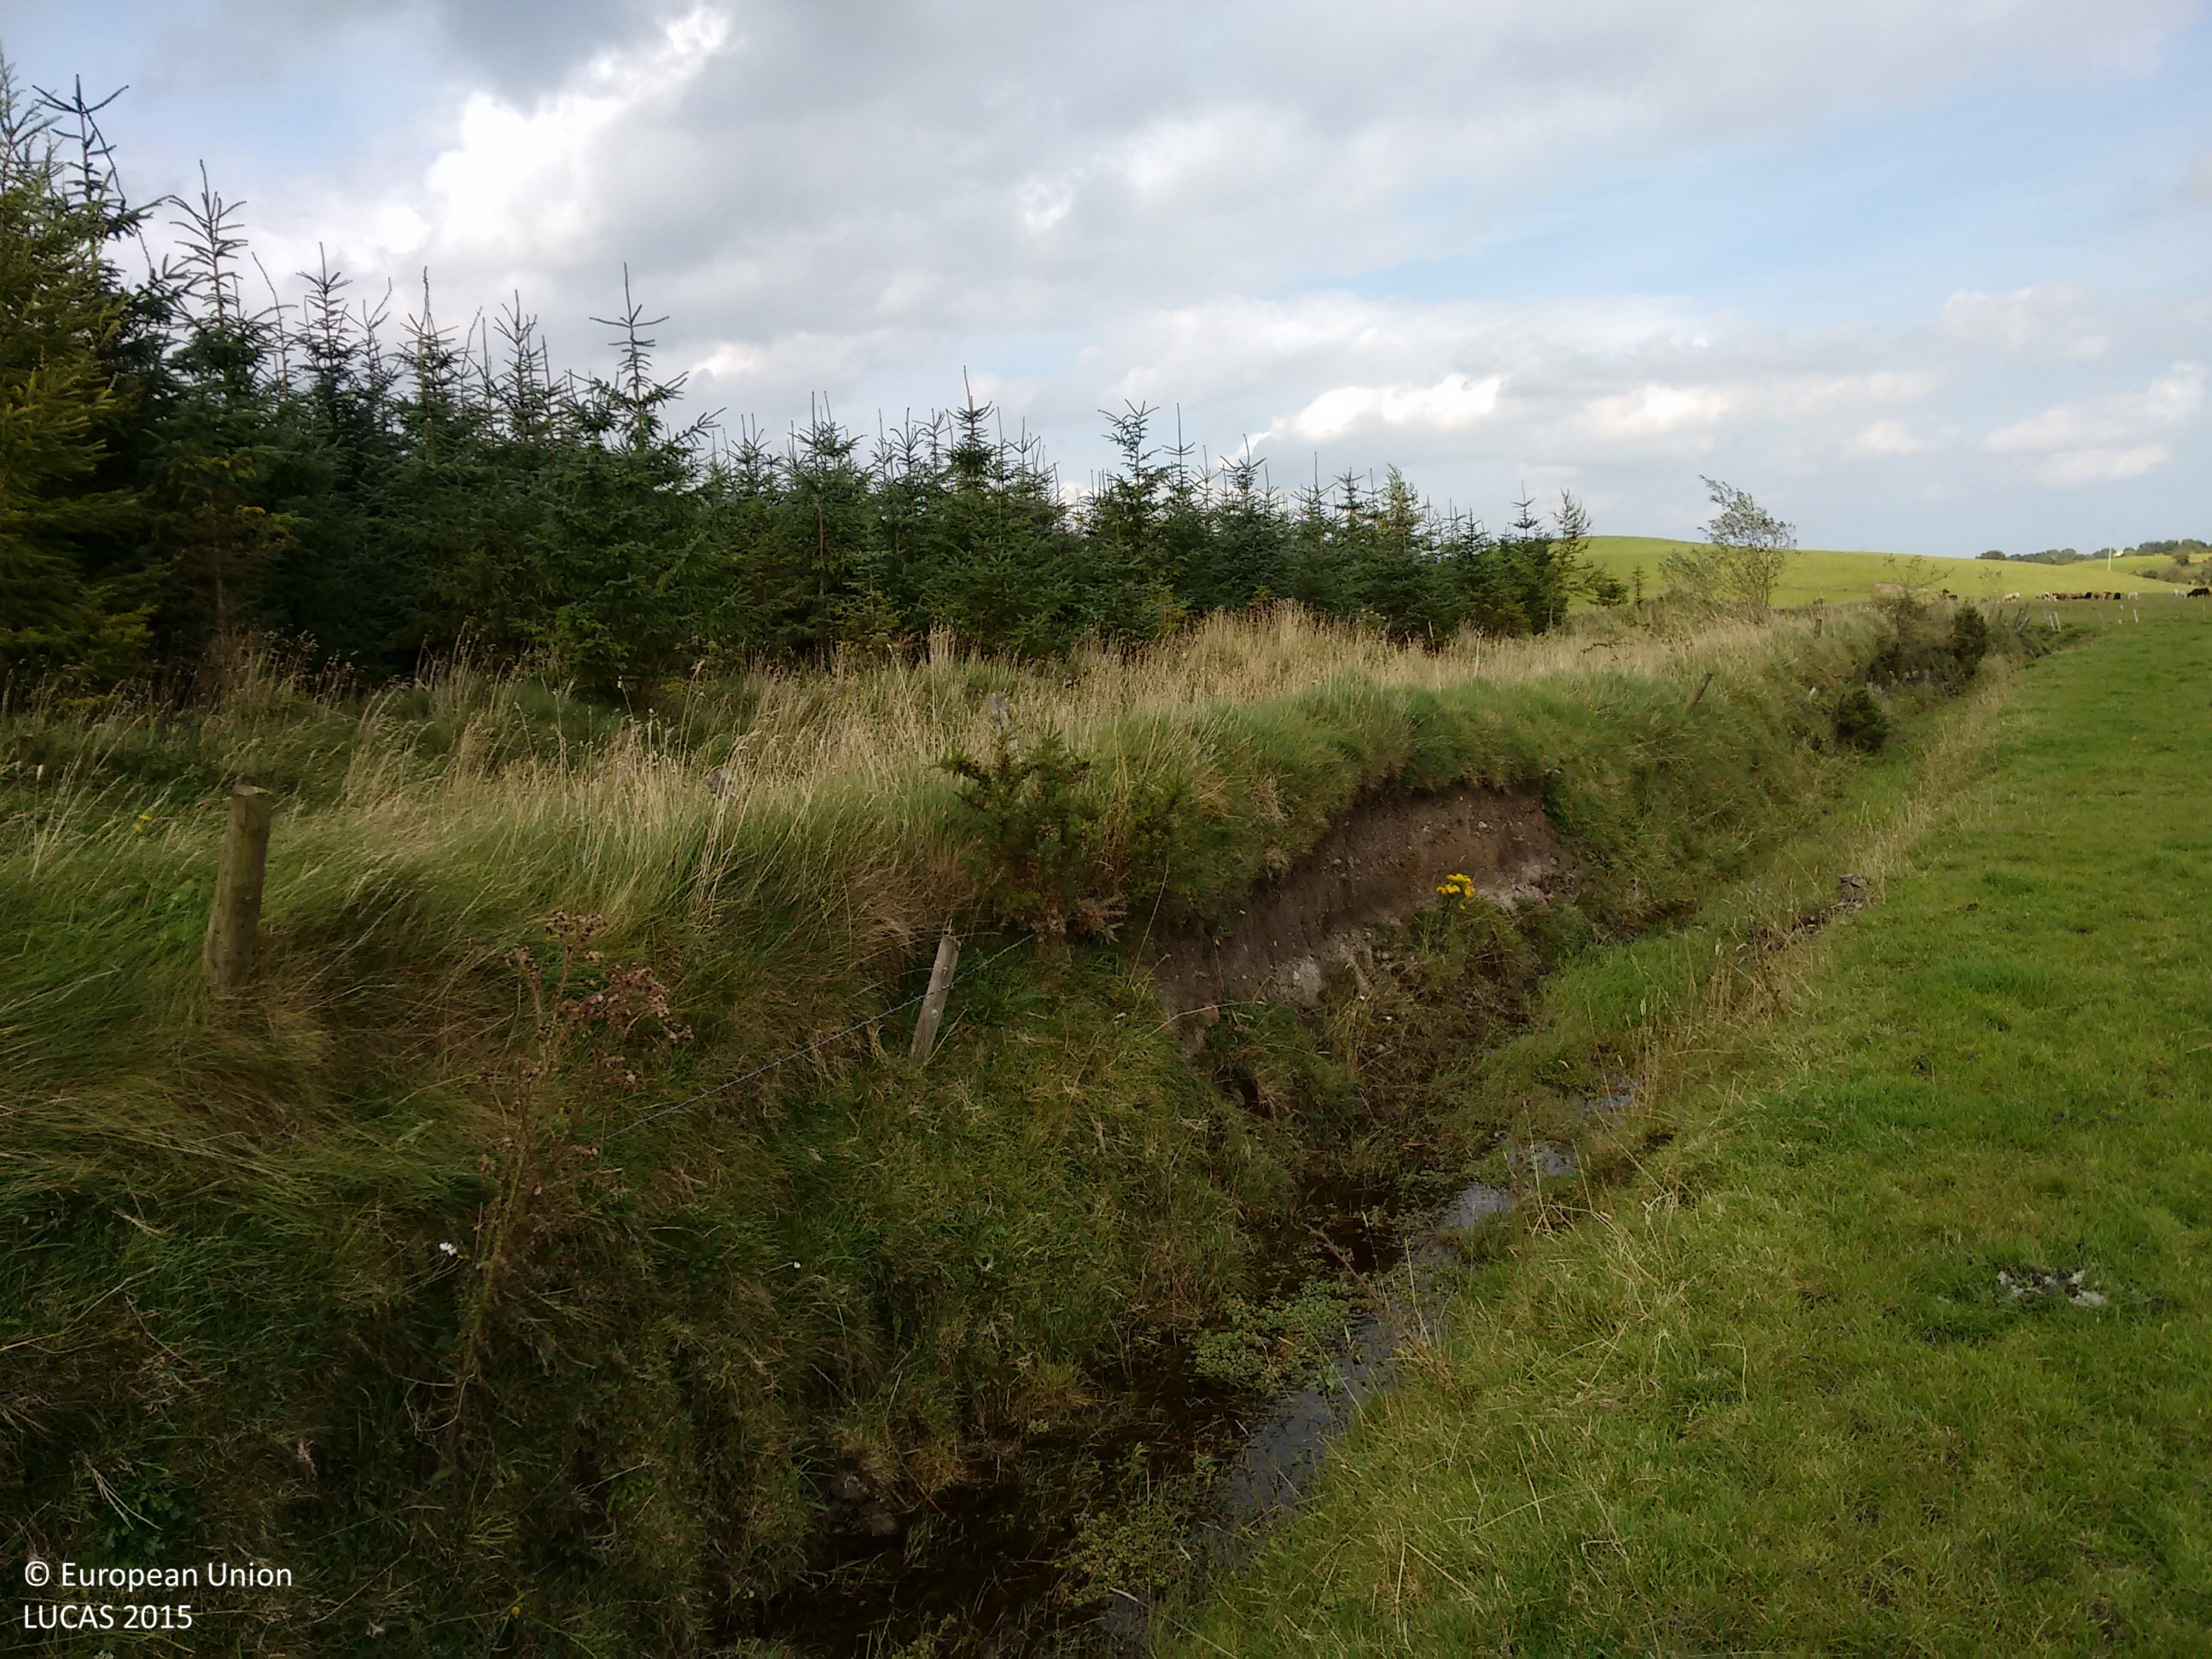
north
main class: Woodland
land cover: Spruce dominated coniferous woodland
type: exotic forest
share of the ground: > 75 %
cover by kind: coniferous forest trees 100 %
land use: Forestry
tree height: > 5 m
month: September
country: IE
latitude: 54.1365
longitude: -9.3419
